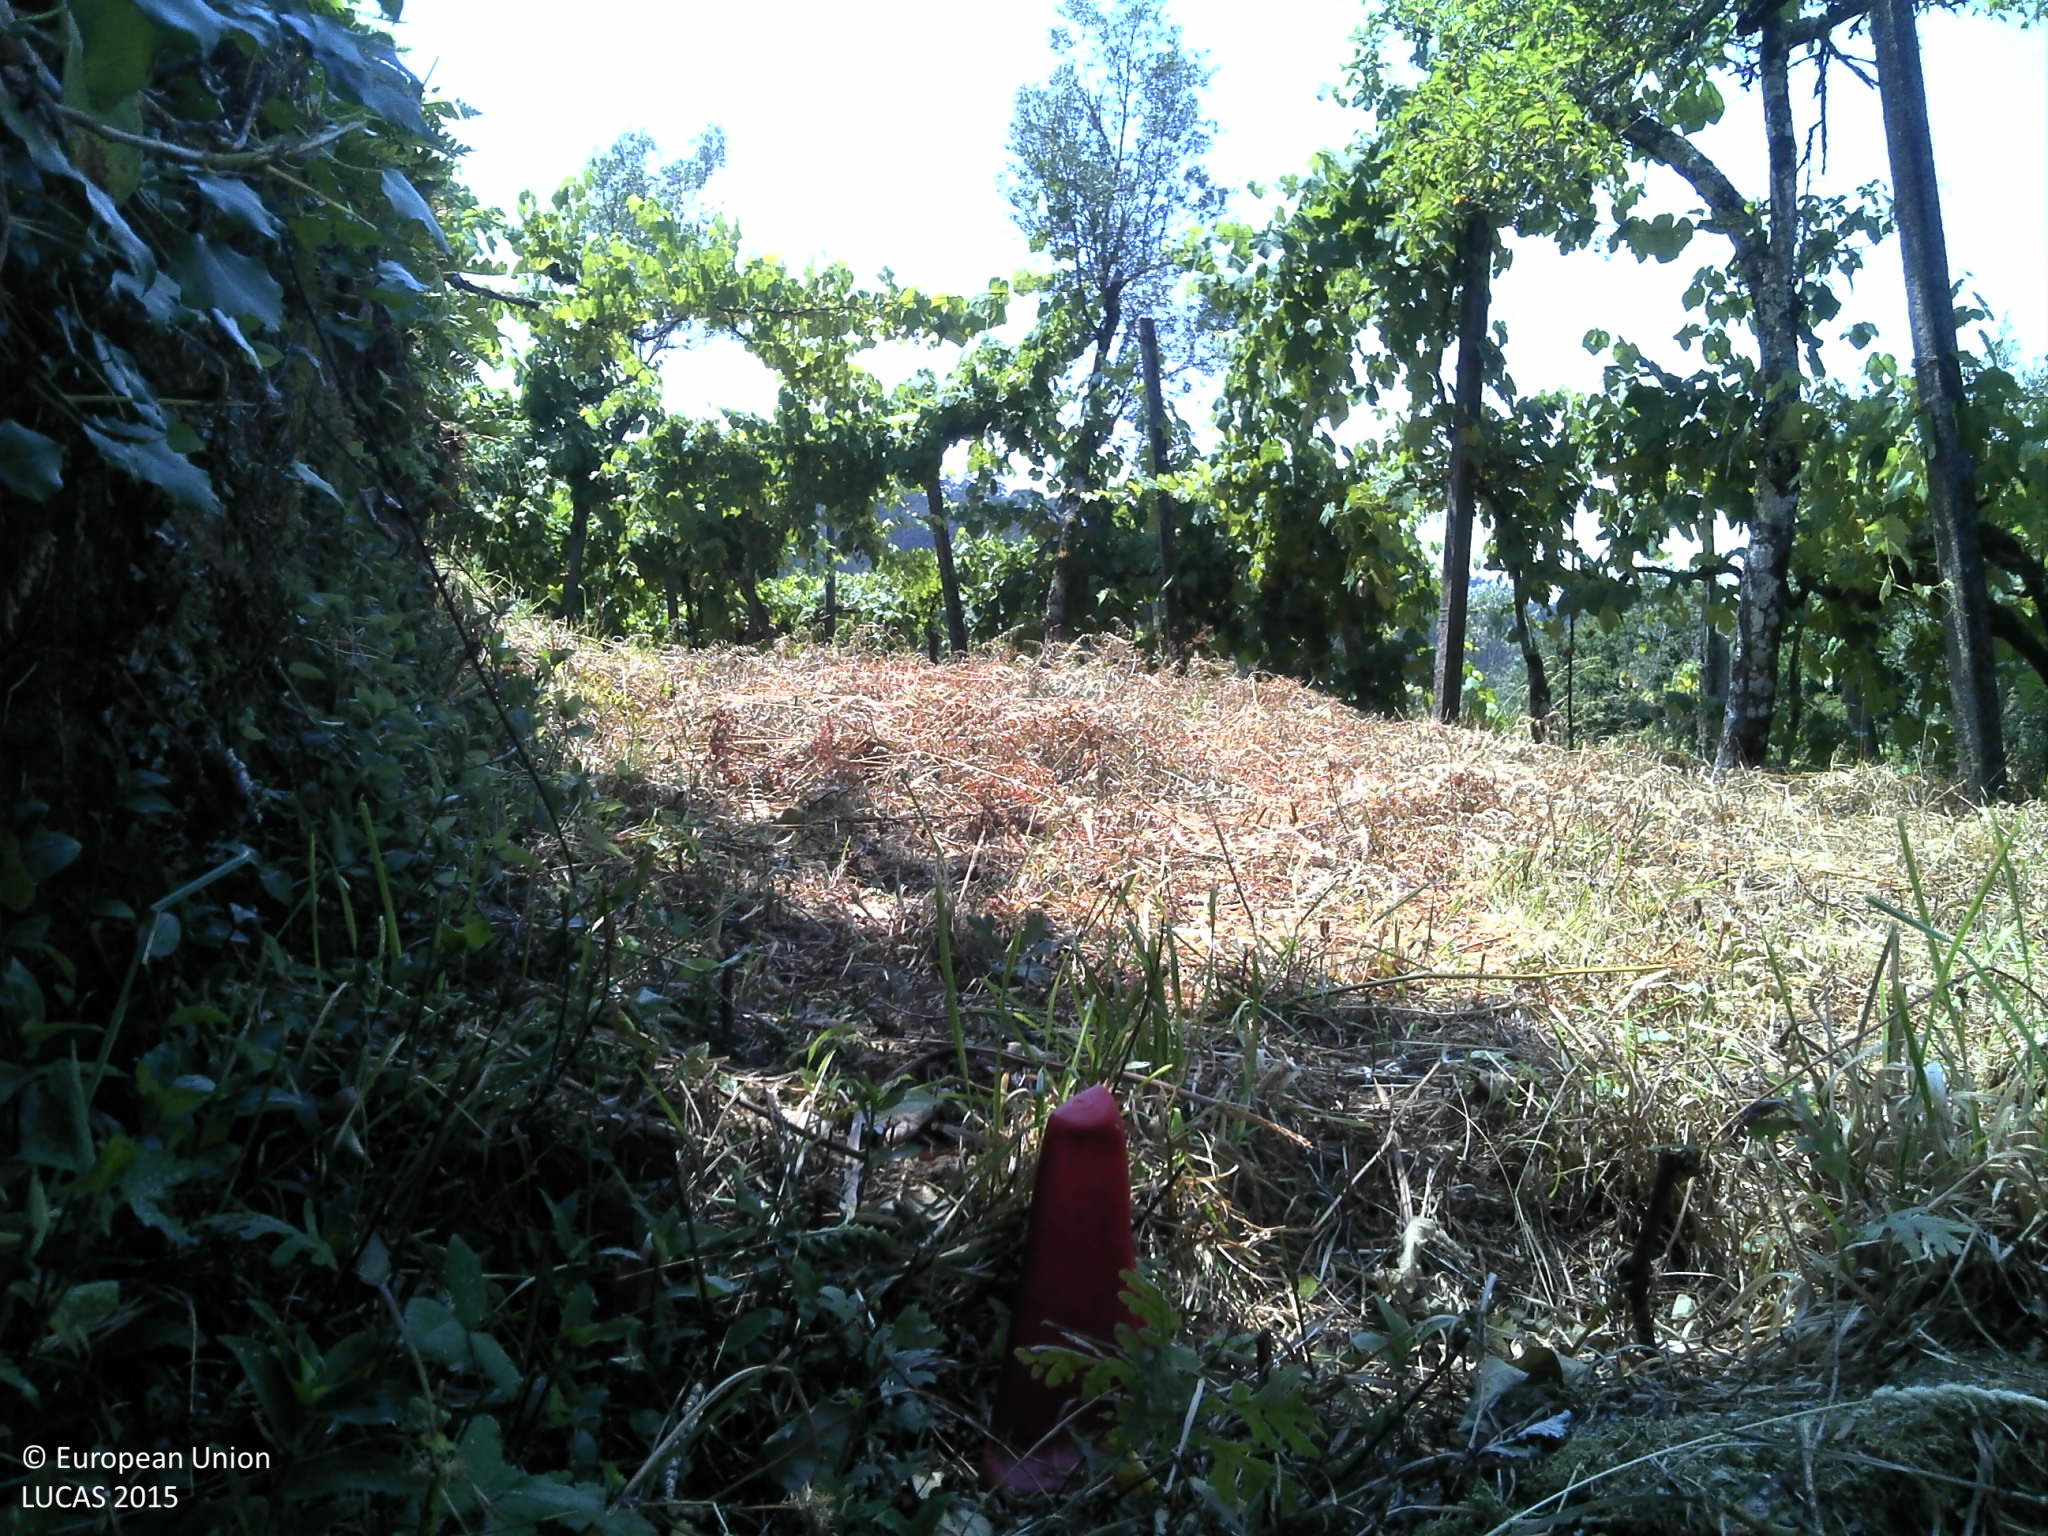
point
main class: Grassland
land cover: Grassland without tree/shrub cover
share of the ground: 50 - 75 %
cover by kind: herbaceous plants 75 %, unconsolidated bare surface 25 %
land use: Agriculture (excluding fallow land and kitchen gardens)
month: June
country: PT
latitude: 40.7276
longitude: -8.3108
